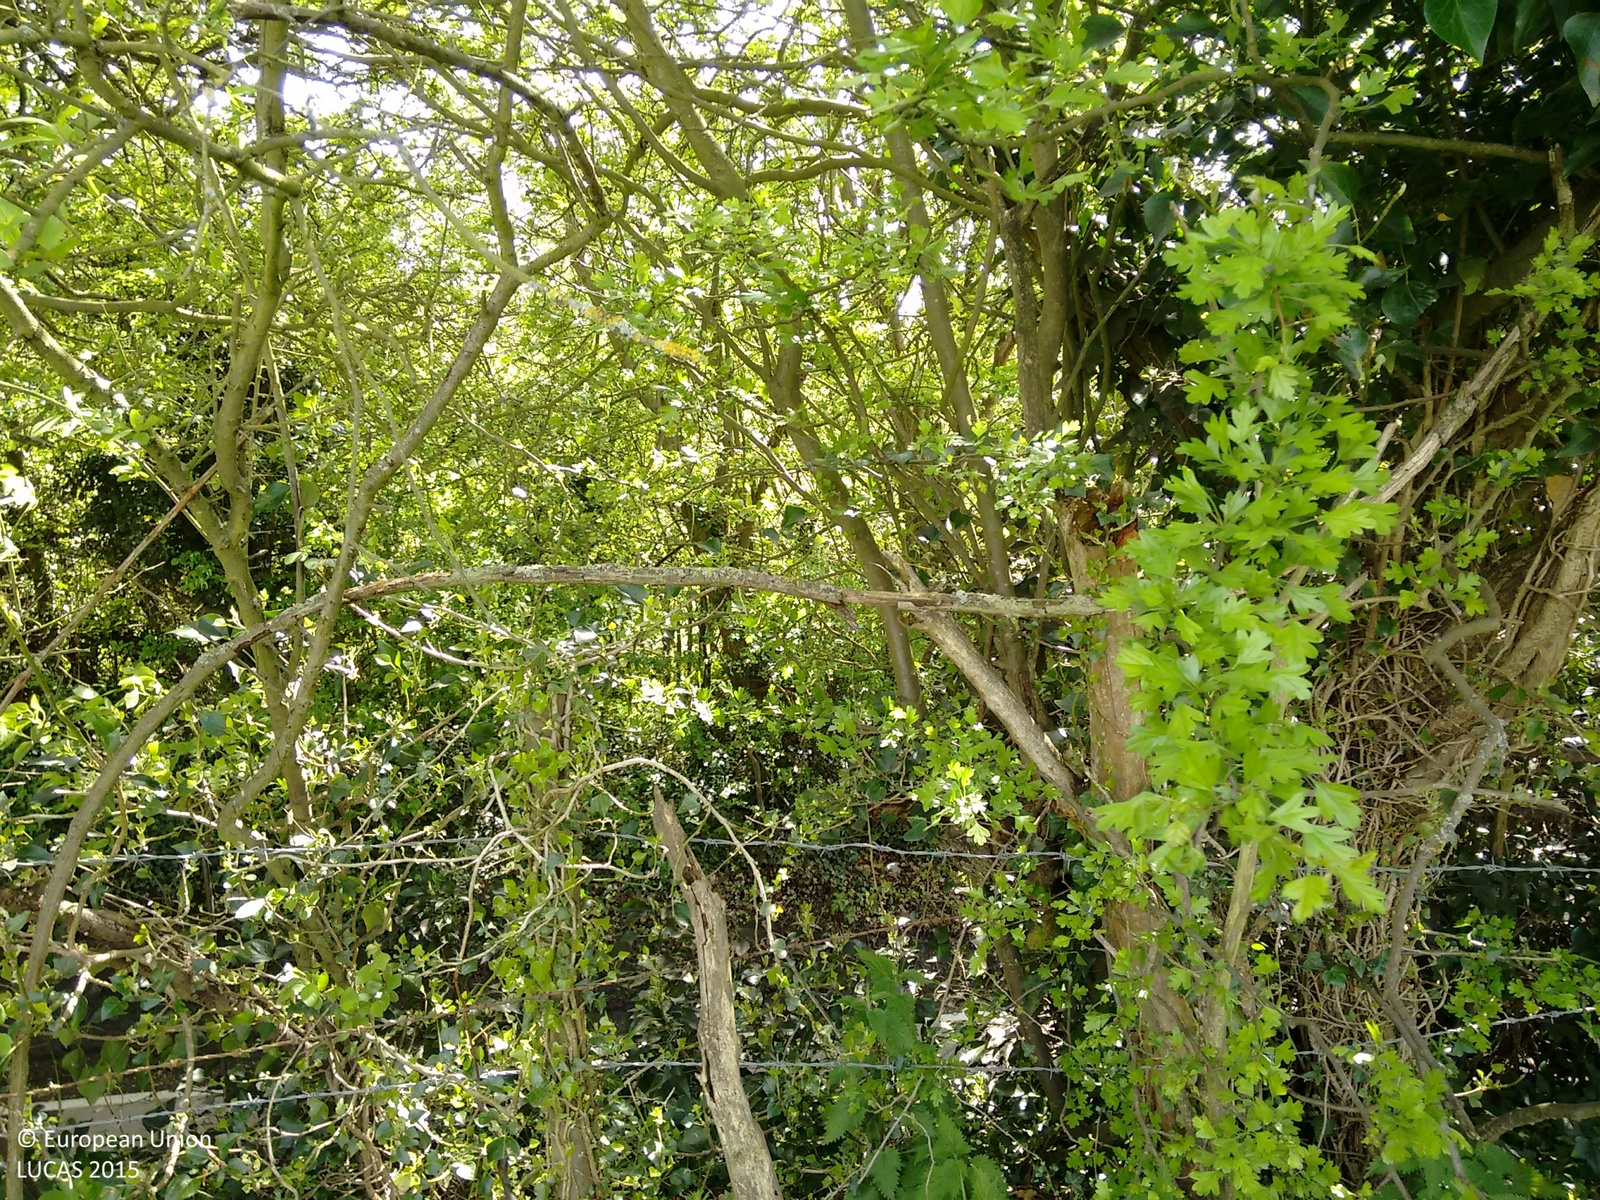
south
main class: Grassland
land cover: Grassland without tree/shrub cover
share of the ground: > 75 %
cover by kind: herbaceous plants 100 %
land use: Agriculture (excluding fallow land and kitchen gardens)
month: May
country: GB
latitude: 51.4173
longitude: 0.2928
